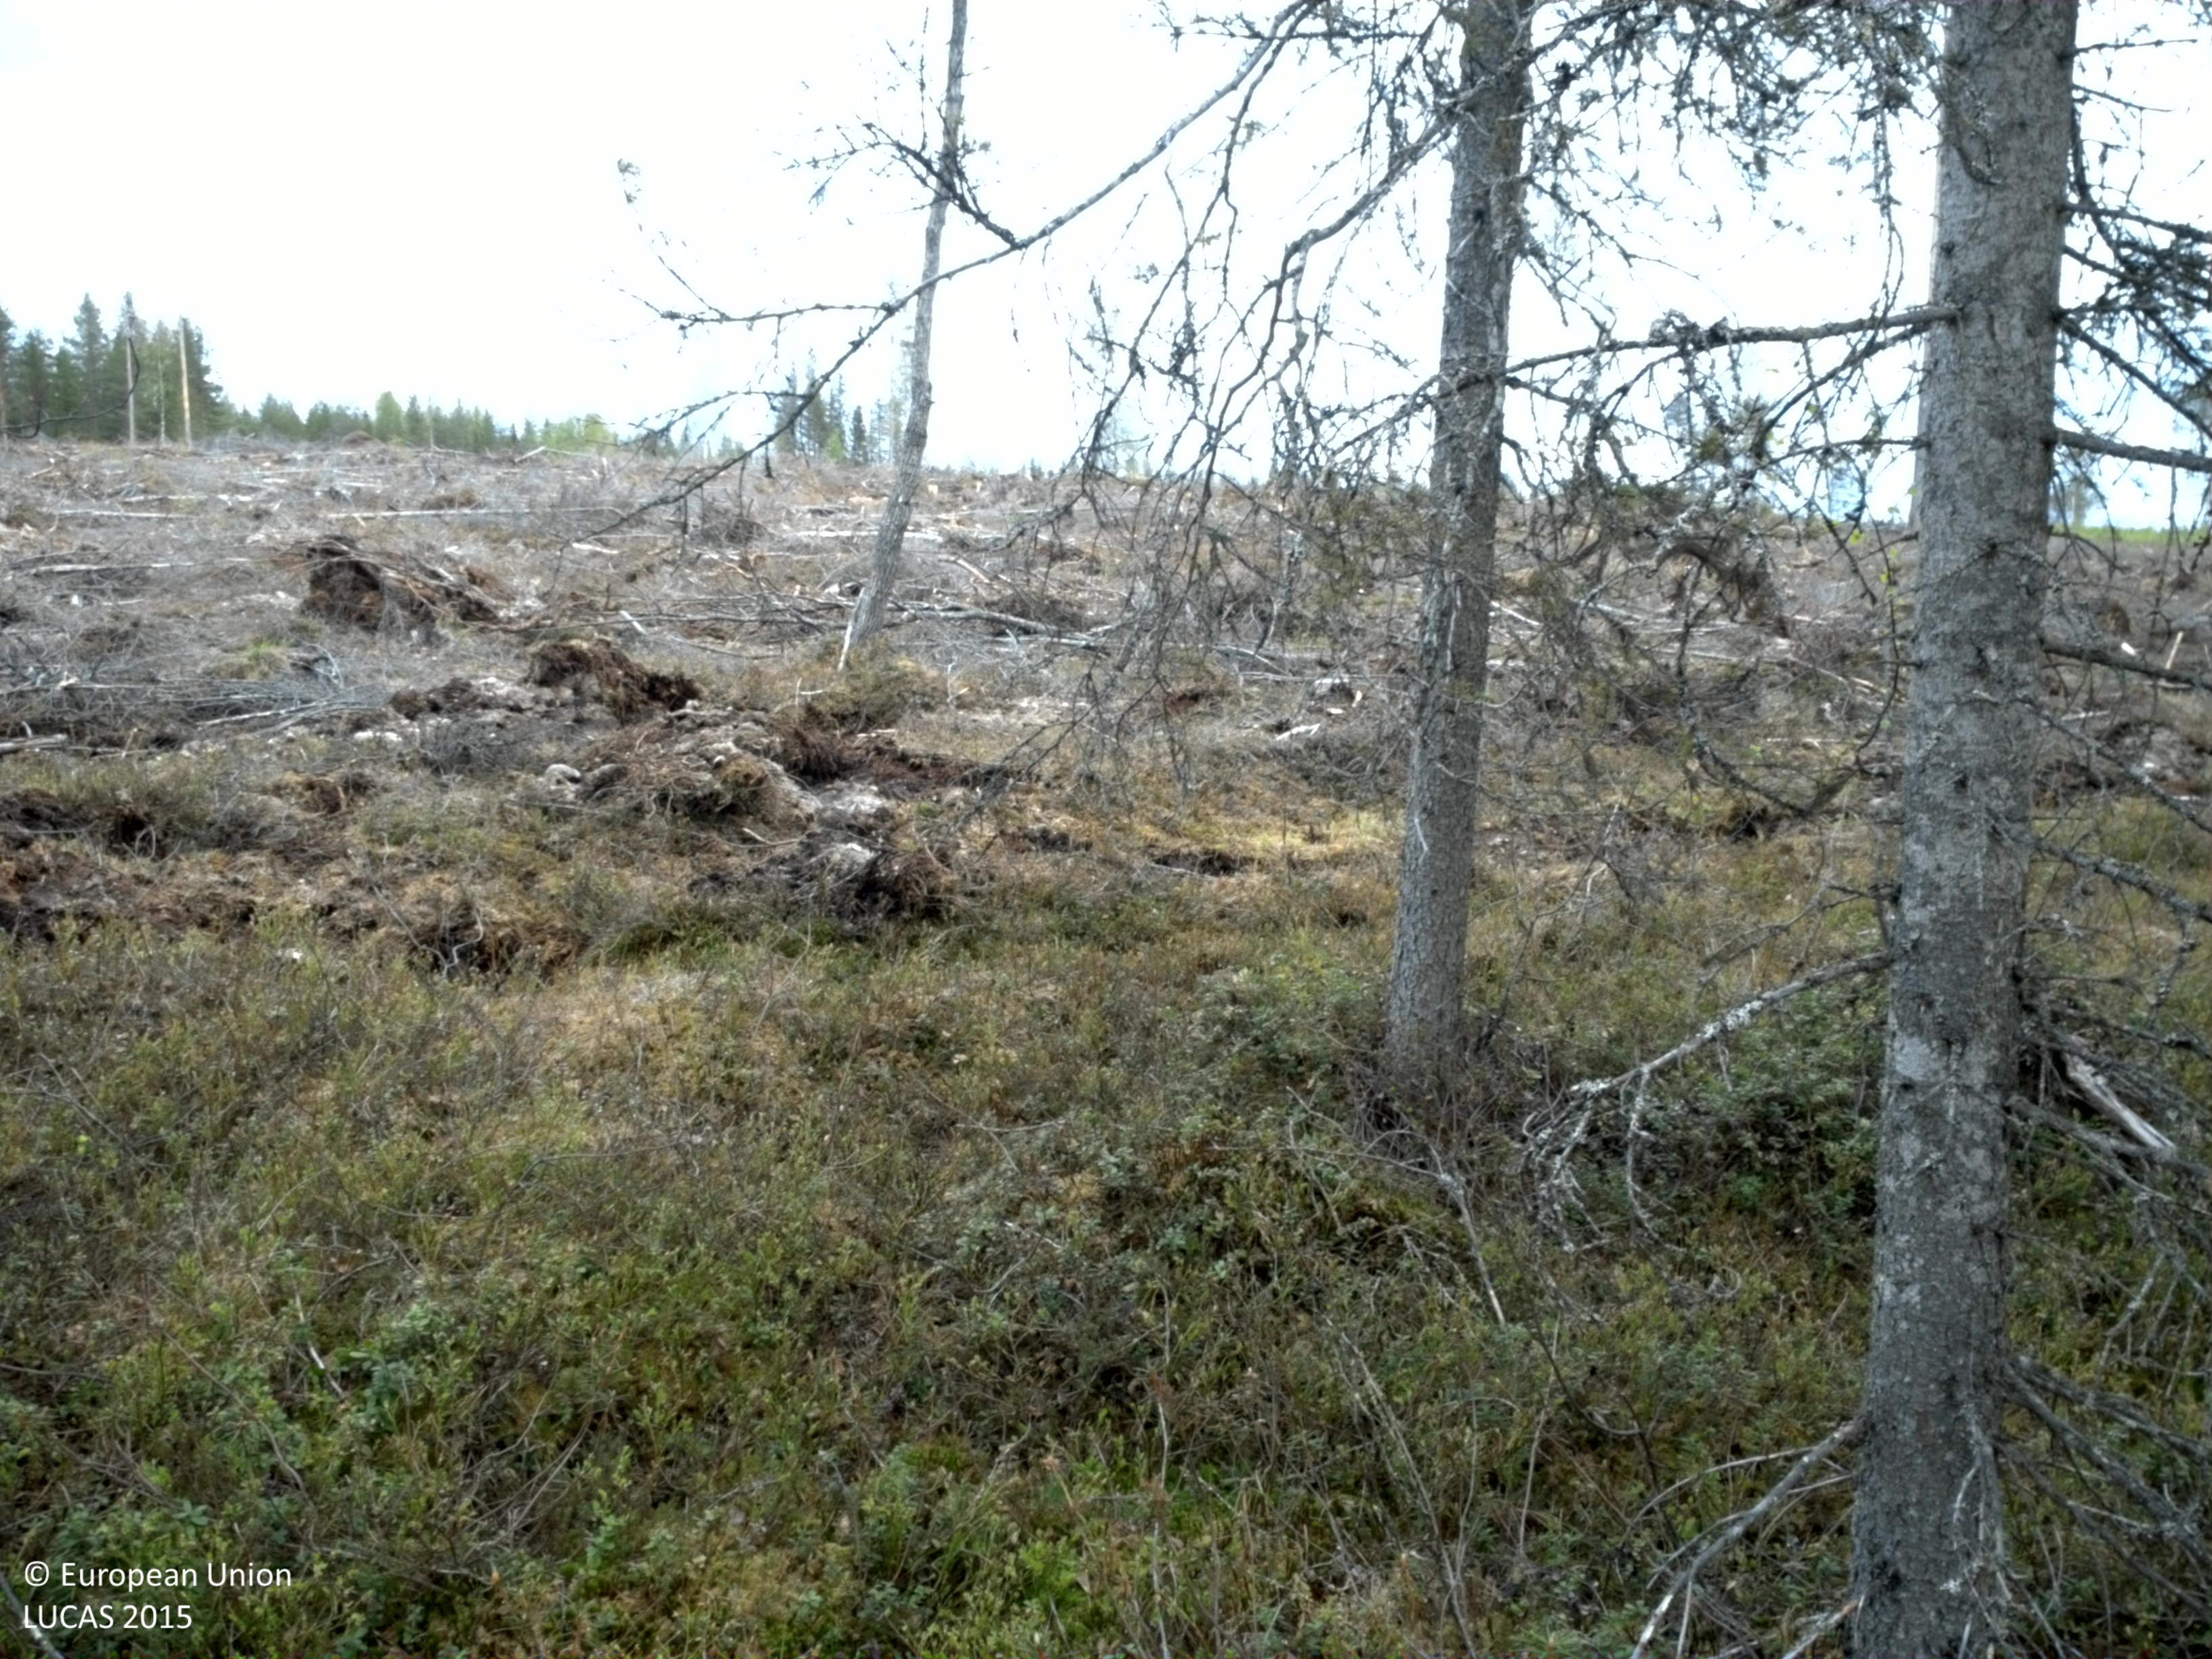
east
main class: Woodland
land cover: Pine dominated coniferous woodland
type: boreal forest
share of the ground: 50 - 75 %
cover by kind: coniferous forest trees 60 %, shrubs 30 %, broadleaved forest trees 10 %
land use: Forestry
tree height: > 5 m
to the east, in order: Pine dominated coniferous woodland; Shrubland without tree cover; Single bushes/trees; Shrubland without tree cover; Grassland with sparse tree/shrub cover; Ditches and canals; Paved roads, cycling and walking lanes; Ditches and canals; Broadleaved woodland
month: June
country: SE
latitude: 66.3313
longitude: 22.4069
